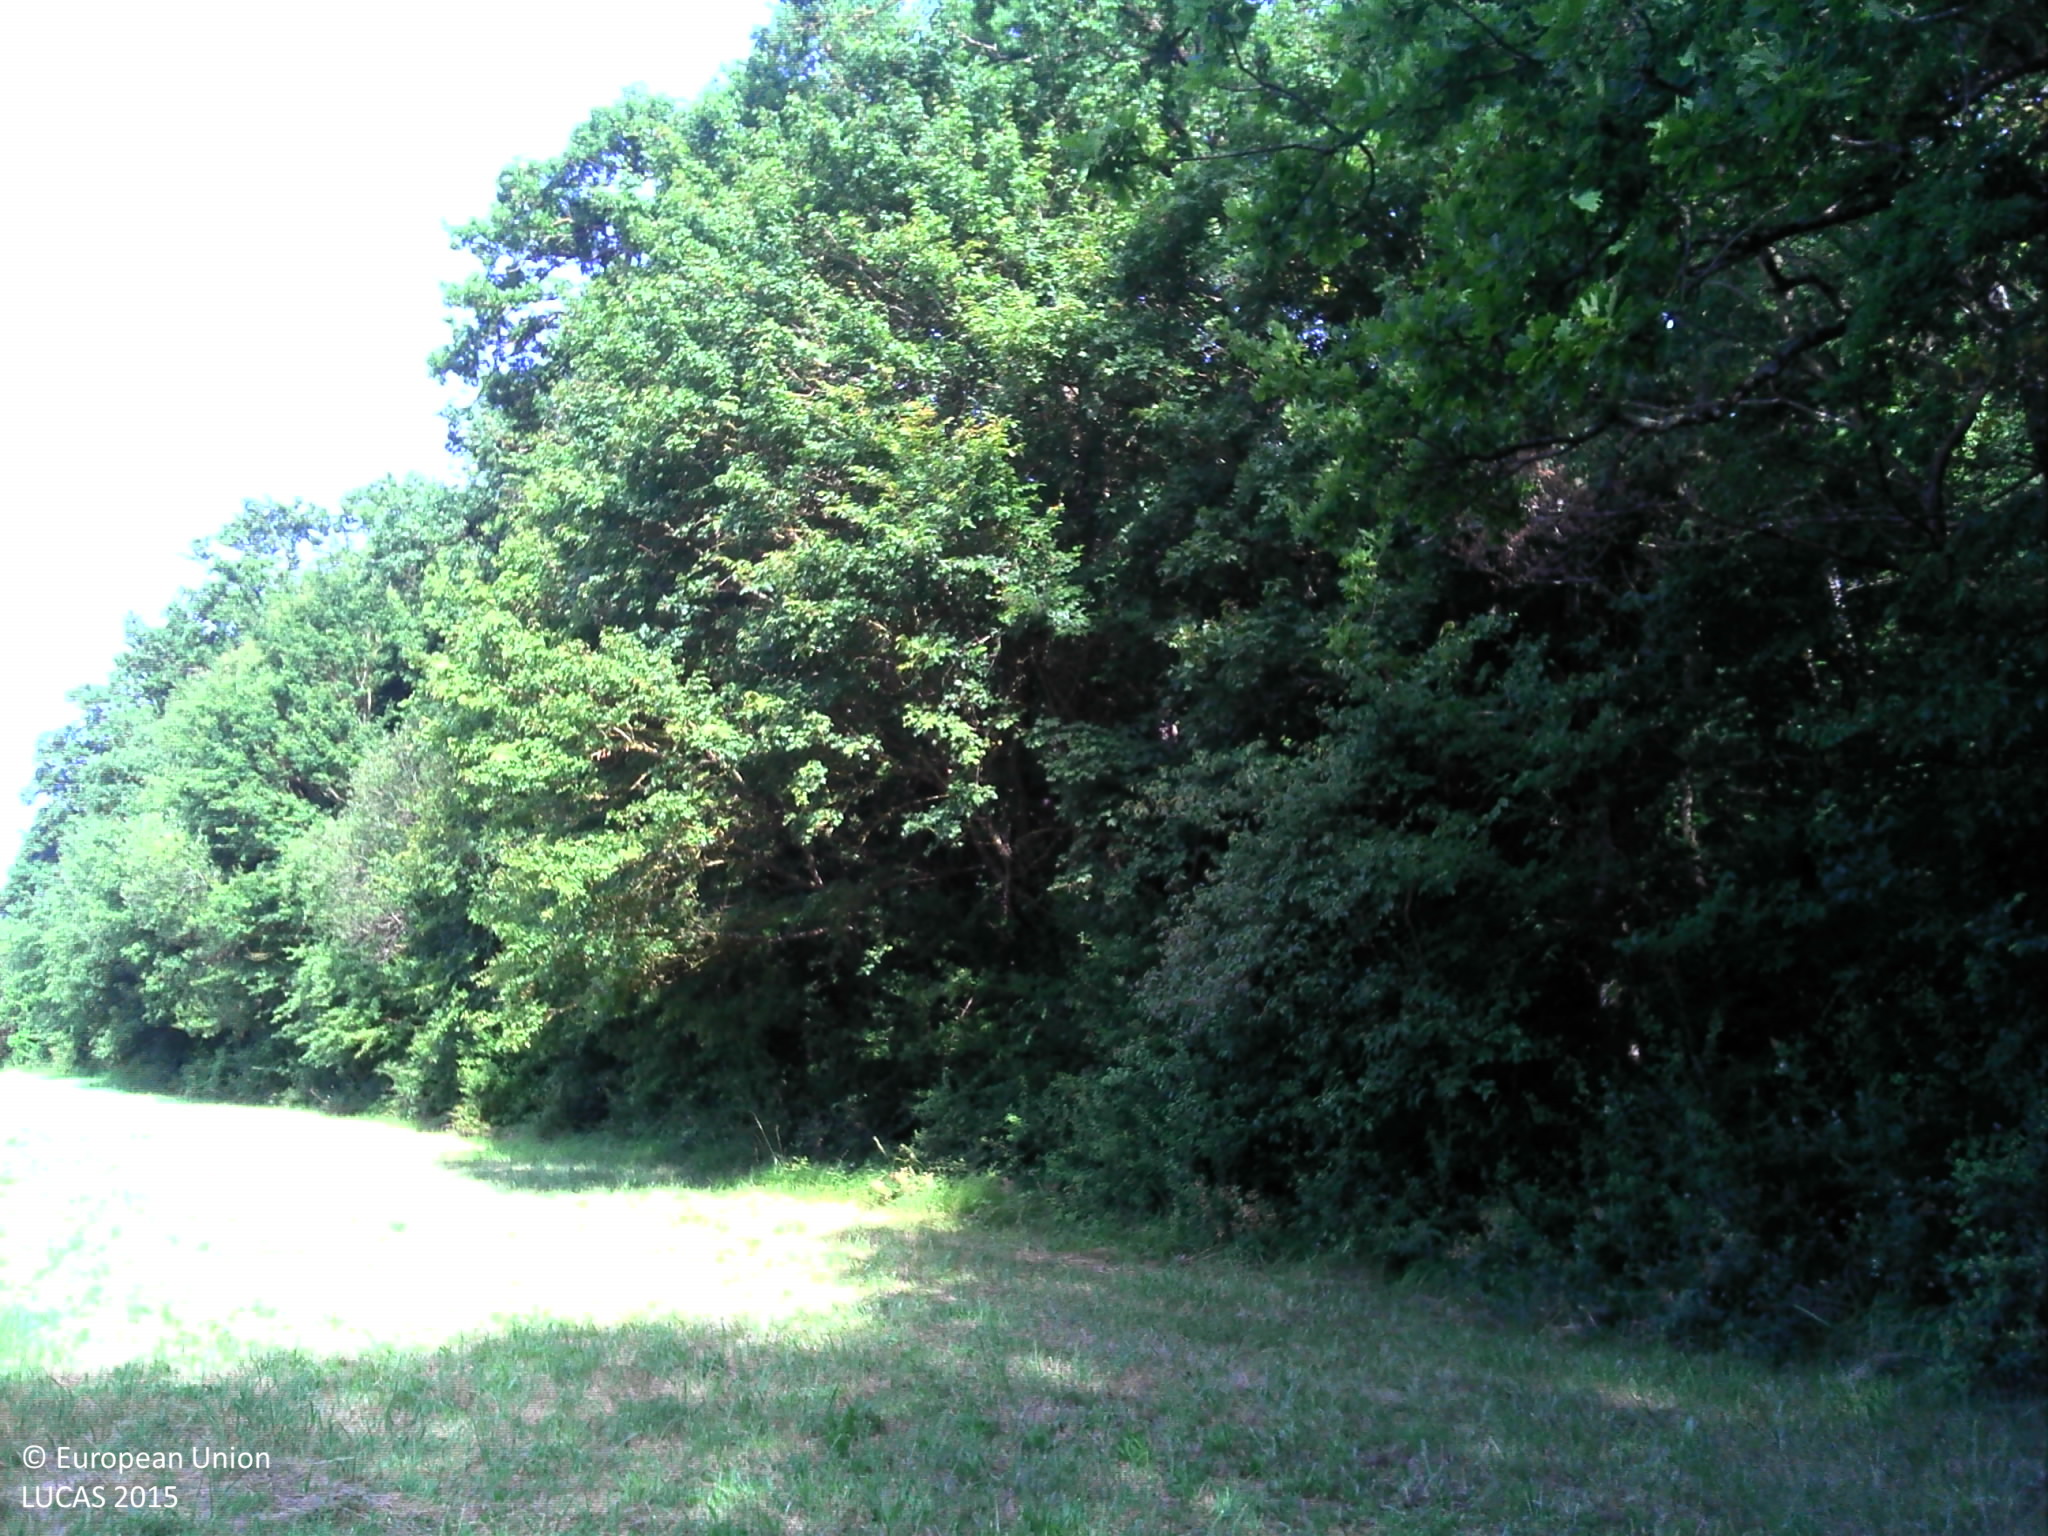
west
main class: Woodland
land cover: Broadleaved woodland
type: mesophytic deciduous forest
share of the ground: > 75 %
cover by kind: broadleaved forest trees 75 %, herbaceous plants 15 %, shrubs 10 %
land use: Forestry
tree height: > 5 m
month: June
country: FR
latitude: 48.3955
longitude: 0.1261
